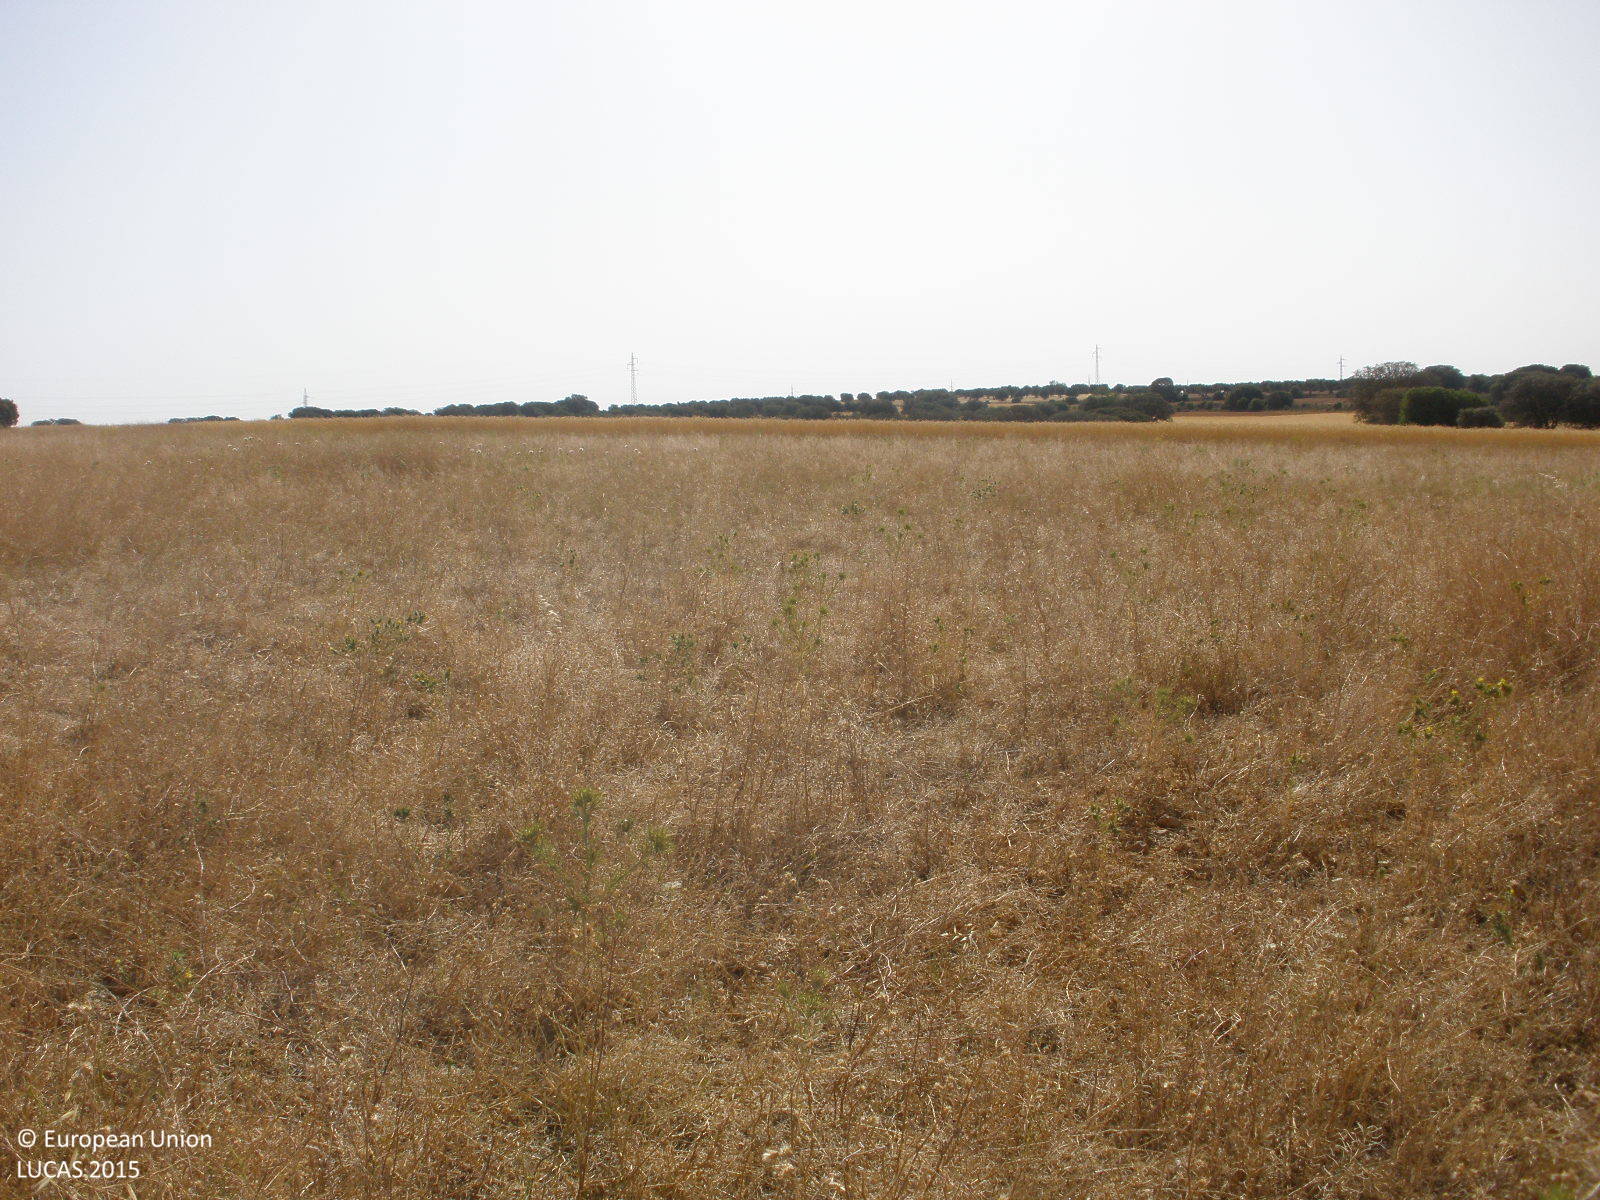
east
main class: Grassland
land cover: Spontaneously vegetated surfaces
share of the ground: > 75 %
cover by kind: herbaceous plants 100 %
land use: Fallow land
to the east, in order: Spontaneously vegetated surfaces; Grass margins; Rye; Grass margins; Tracks; Grass margins; Rye
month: July
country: ES
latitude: 40.2654
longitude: -3.3539
